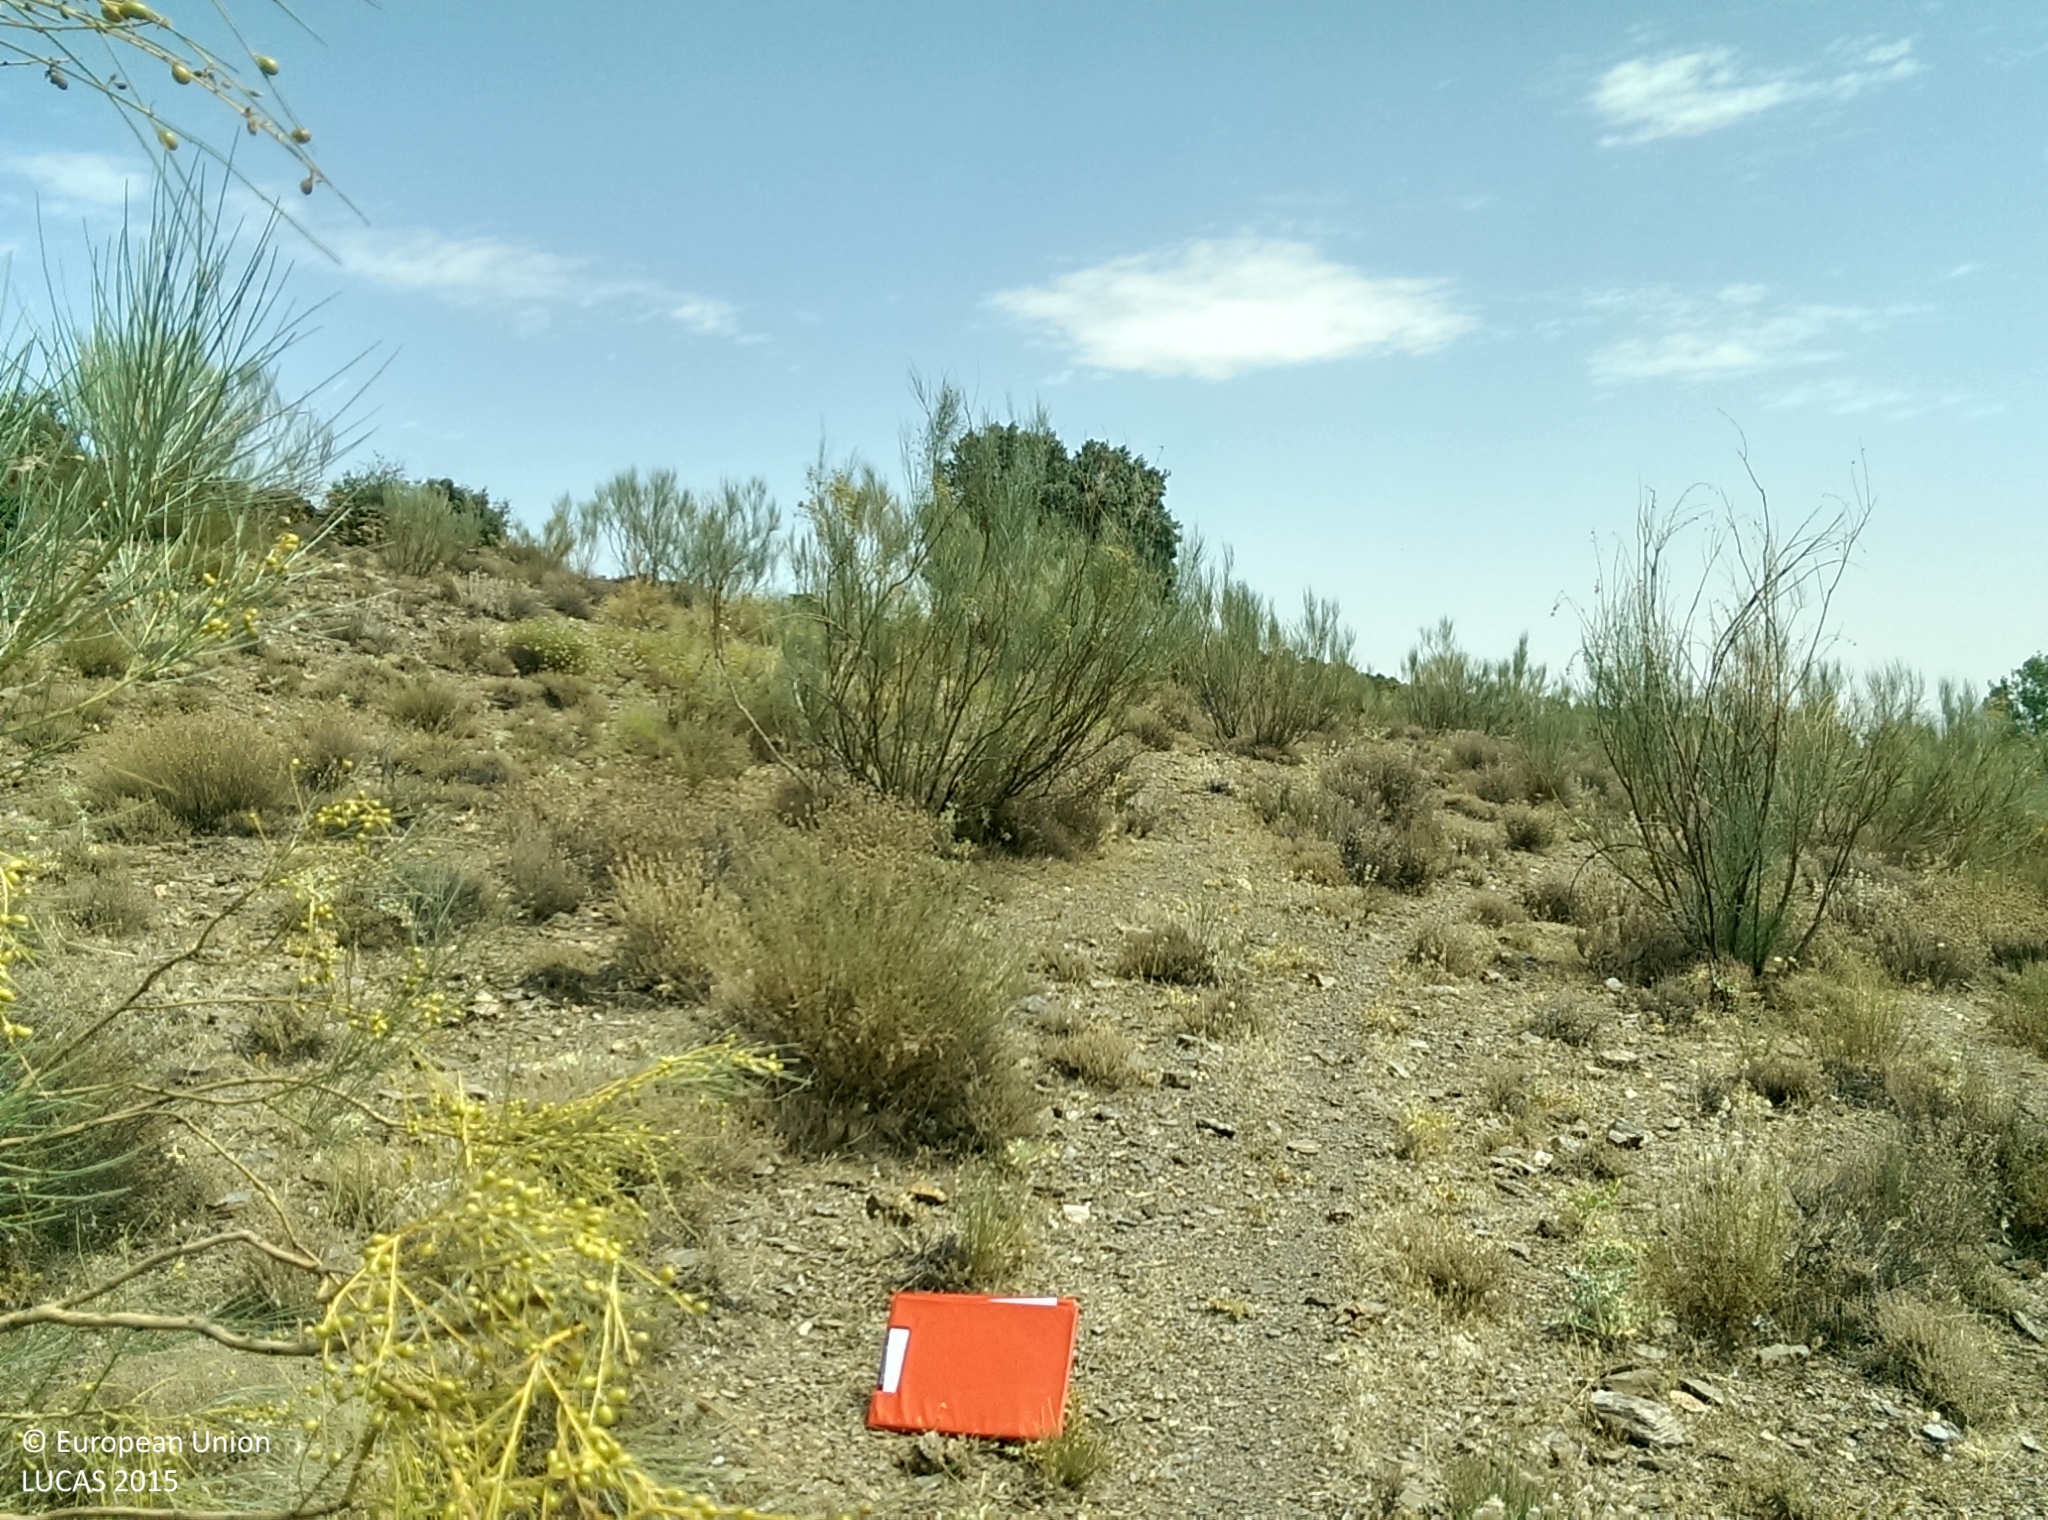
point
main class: Shrubland
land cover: Shrubland without tree cover
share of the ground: 50 - 75 %
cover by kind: shrubs 50 %, herbaceous plants 30 %, unconsolidated bare surface 20 %
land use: Semi-natural and natural areas not in use
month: July
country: ES
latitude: 37.1753
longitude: -3.1743
